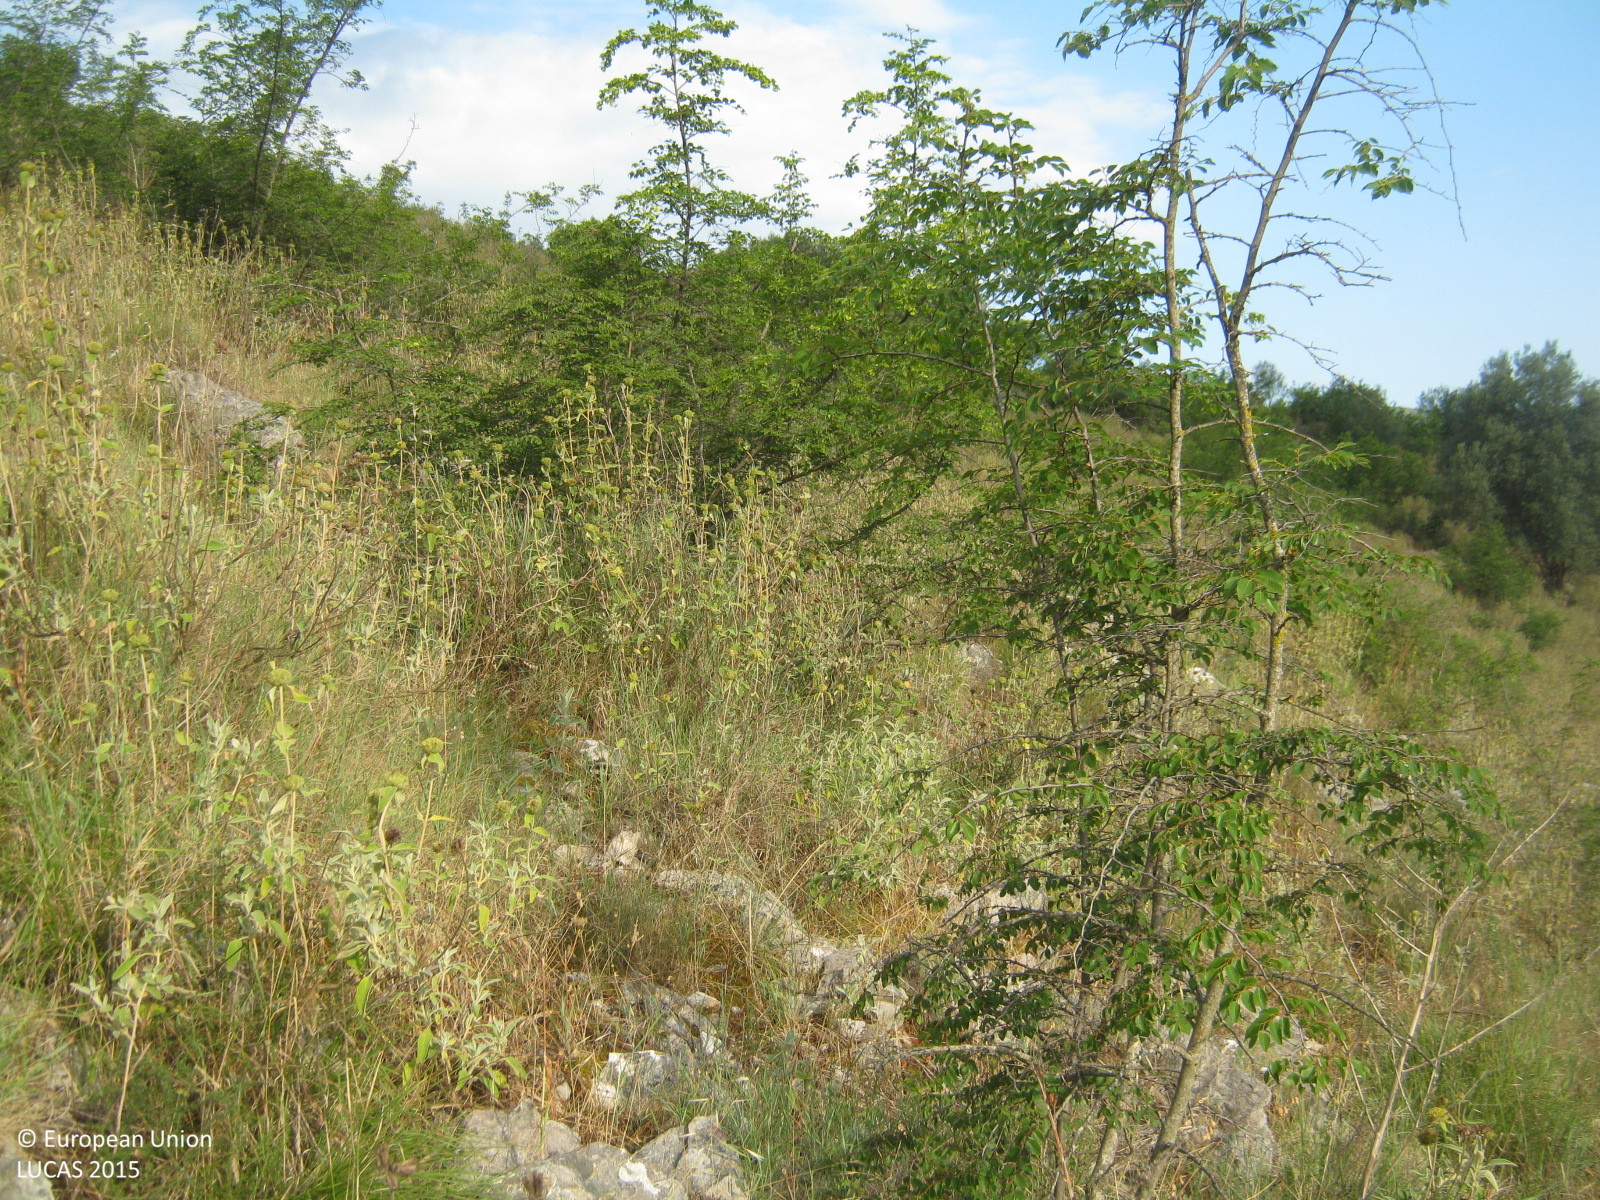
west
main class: Grassland
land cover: Grassland with sparse tree/shrub cover
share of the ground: > 75 %
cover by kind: herbaceous plants 80 %, shrubs 10 %, broadleaved forest trees 5 %, consolidated bare surface 5 %
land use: Semi-natural and natural areas not in use
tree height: < 5 m
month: June
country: GR
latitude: 39.4097
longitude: 20.5078
